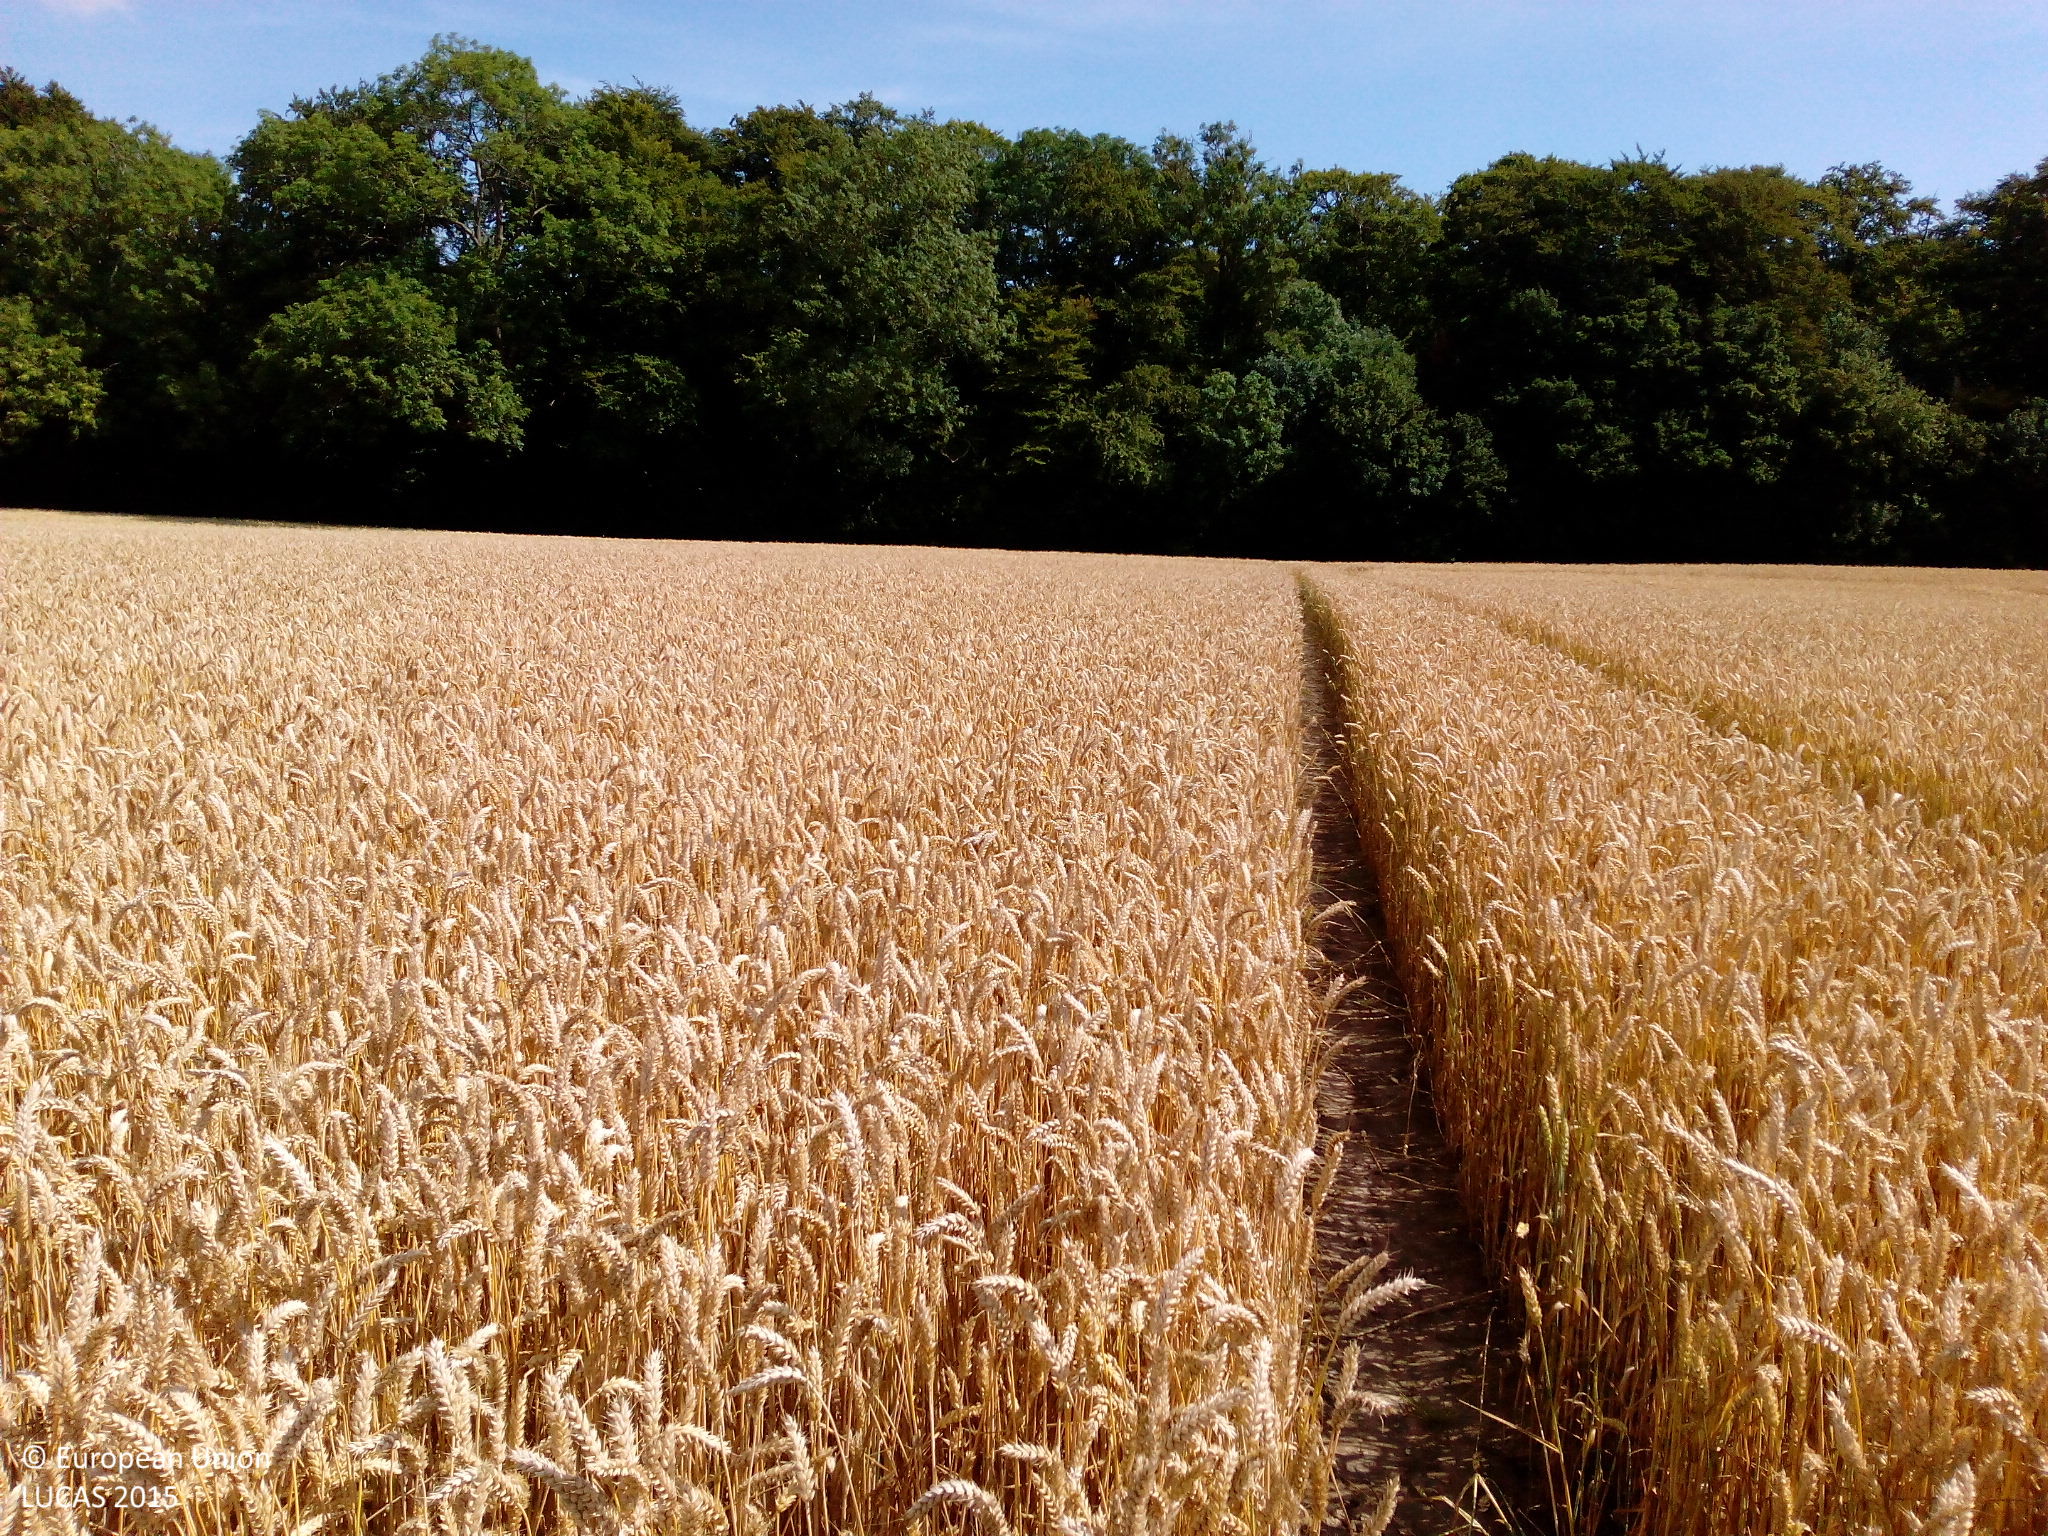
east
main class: Cropland
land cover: Common wheat
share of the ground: > 75 %
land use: Agriculture (excluding fallow land and kitchen gardens)
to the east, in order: Common wheat; Broadleaved woodland; Fences; Paved roads, cycling and walking lanes; Fences; Broadleaved woodland; Ditches and canals; Broadleaved woodland; Ditches and canals; Broadleaved woodland
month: August
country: DK
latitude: 55.4154
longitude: 12.0993
